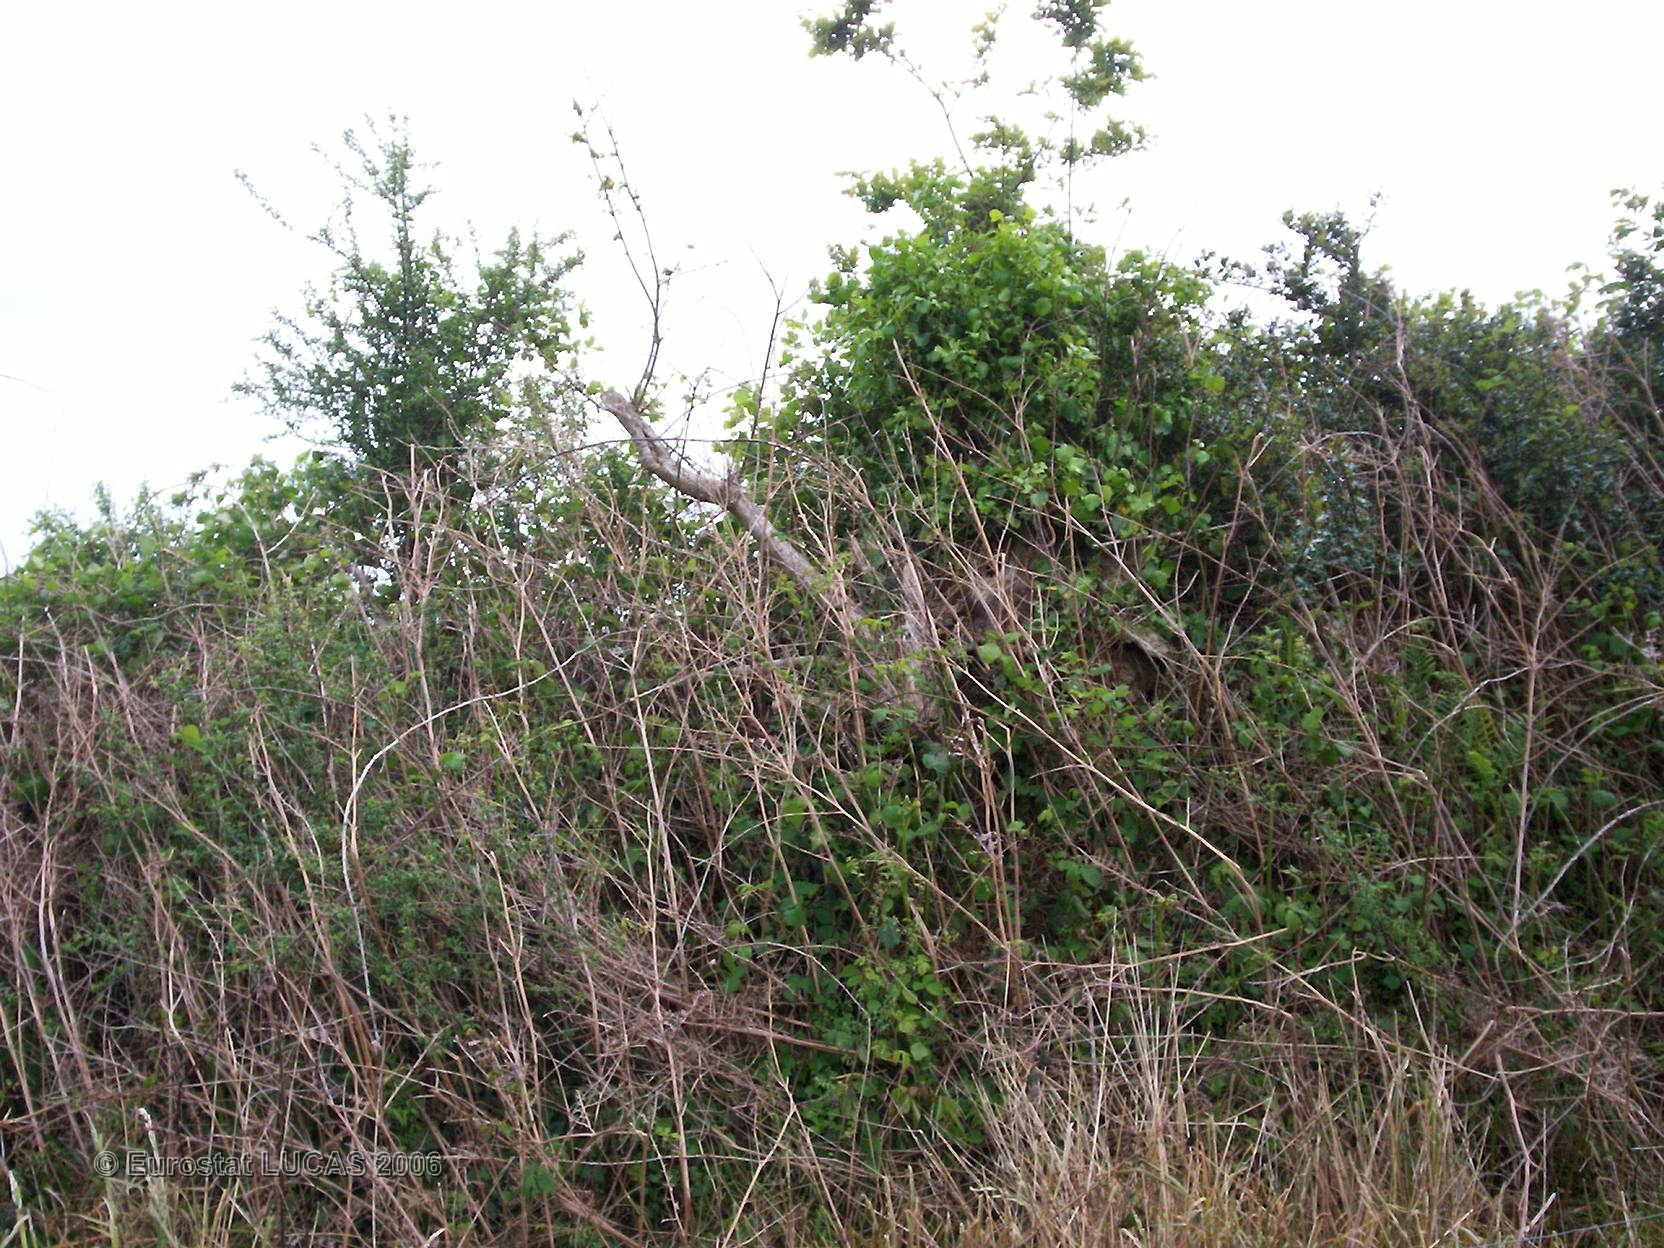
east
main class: Grassland
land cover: Grassland without tree/shrub cover
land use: Agriculture (excluding fallow land and kitchen gardens)
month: May
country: FR
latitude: 47.9771
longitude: -3.8960
